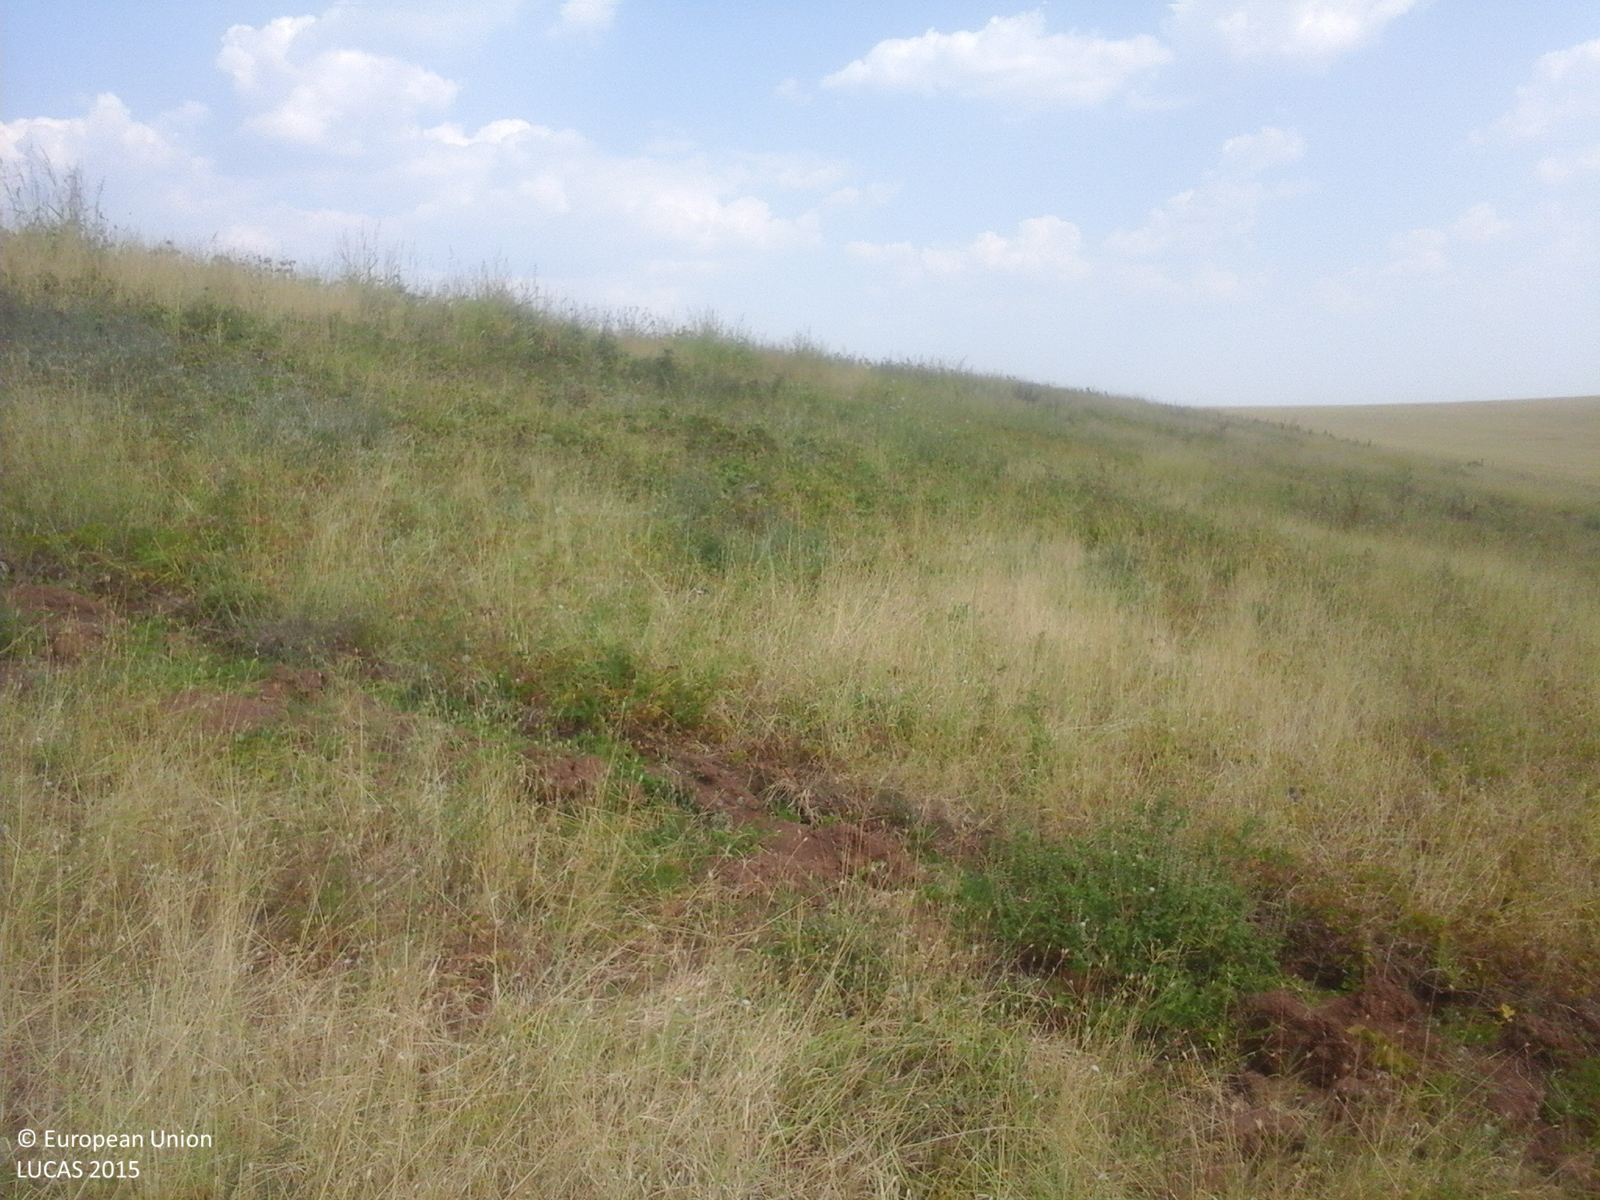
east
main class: Grassland
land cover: Spontaneously vegetated surfaces
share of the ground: > 75 %
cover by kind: herbaceous plants 100 %
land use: Fallow land
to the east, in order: Spontaneously vegetated surfaces; Sunflower
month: August
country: RO
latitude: 44.3736
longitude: 22.9577
